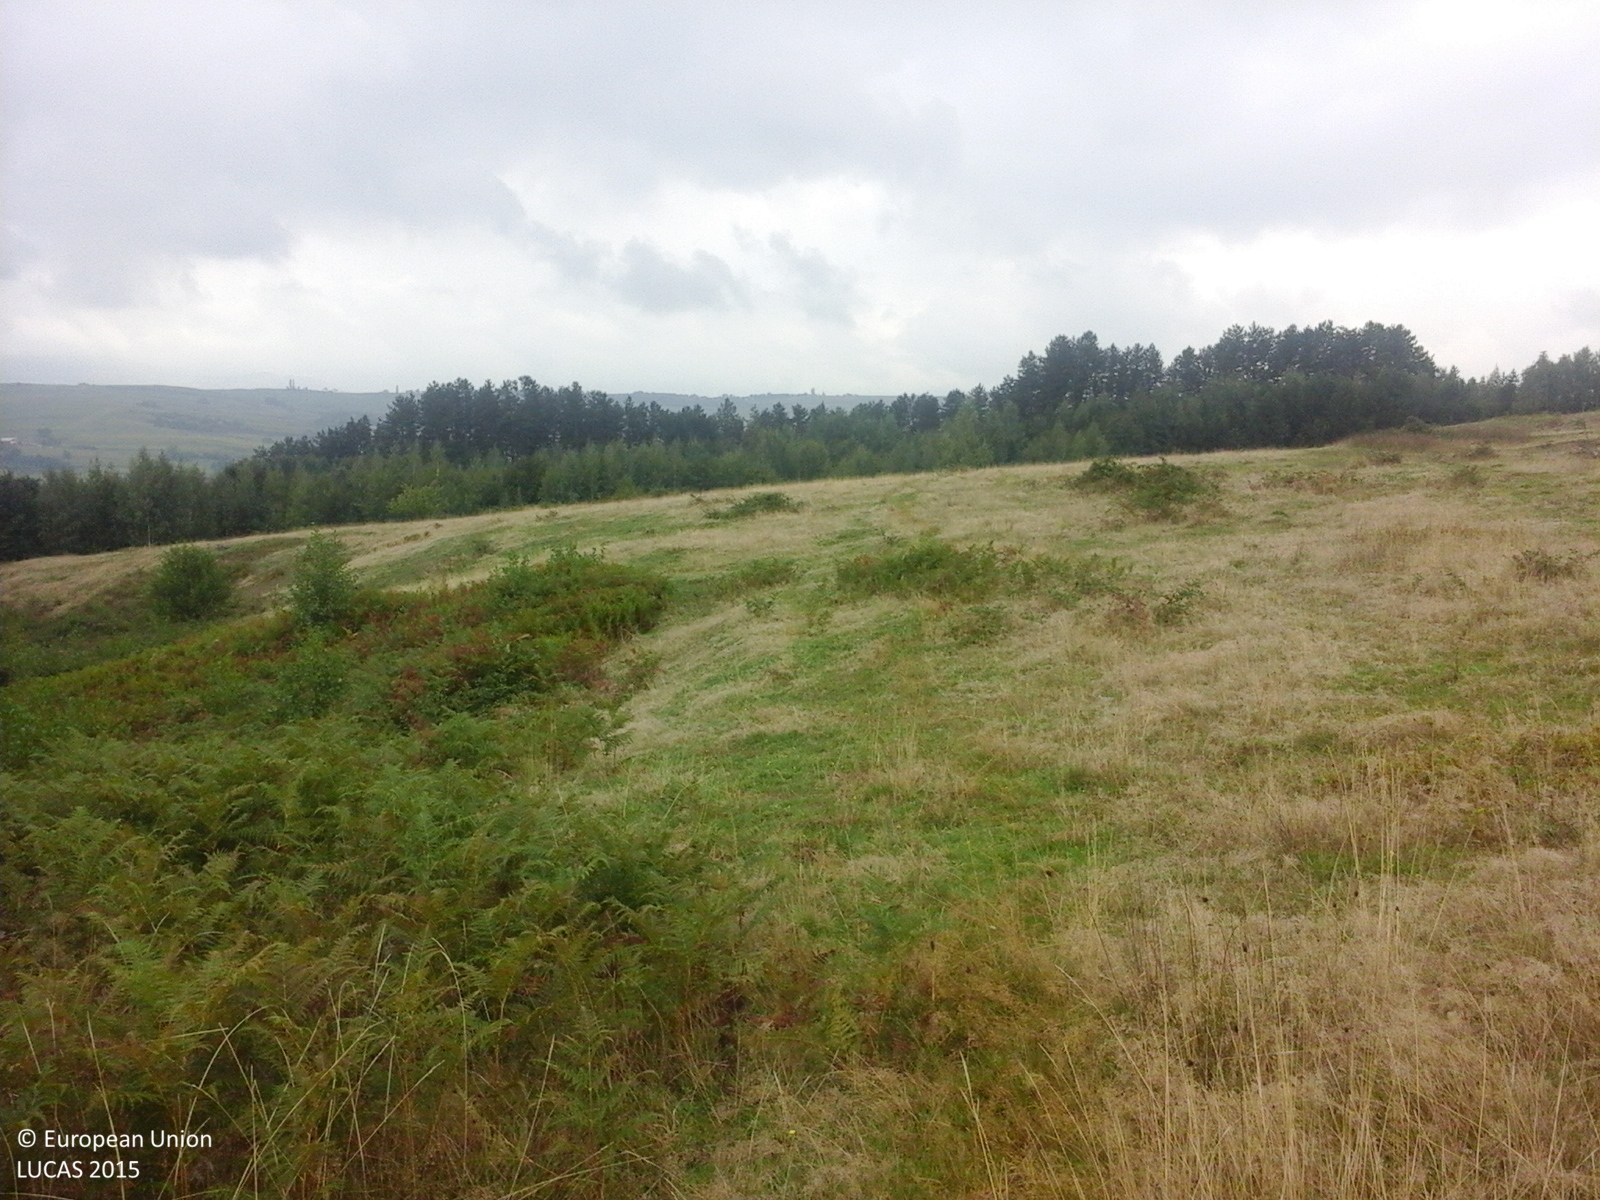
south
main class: Grassland
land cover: Spontaneously vegetated surfaces
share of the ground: > 75 %
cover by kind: herbaceous plants 100 %
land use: Fallow land
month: September
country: RO
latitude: 47.0035
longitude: 22.6163
